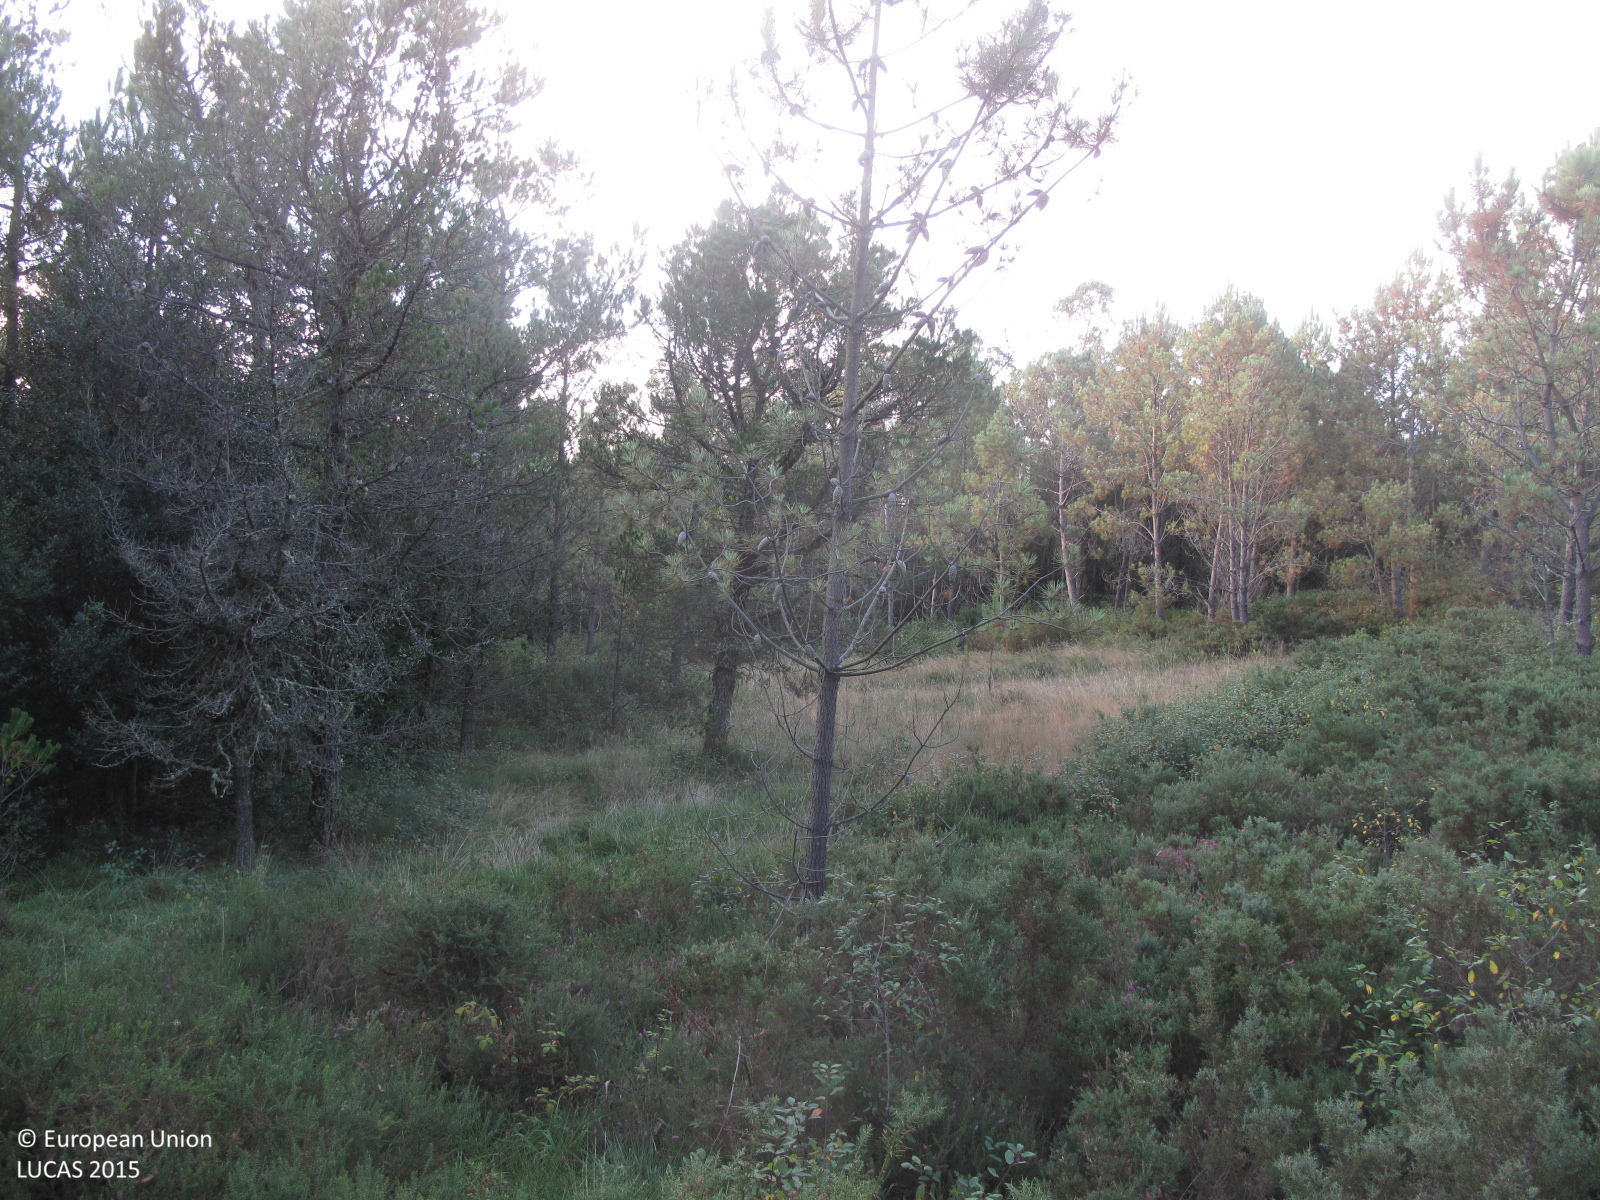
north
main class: Woodland
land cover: Pine dominated coniferous woodland
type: hemiboreal forest and nemoral coniferous forest and mixed broadleaved-coniferous forest
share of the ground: 25 - 50 %
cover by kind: shrubs 50 %, coniferous forest trees 40 %, broadleaved forest trees 5 %, herbaceous plants 5 %
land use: Forestry
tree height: > 5 m
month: July
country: ES
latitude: 42.9950
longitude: -9.1249
